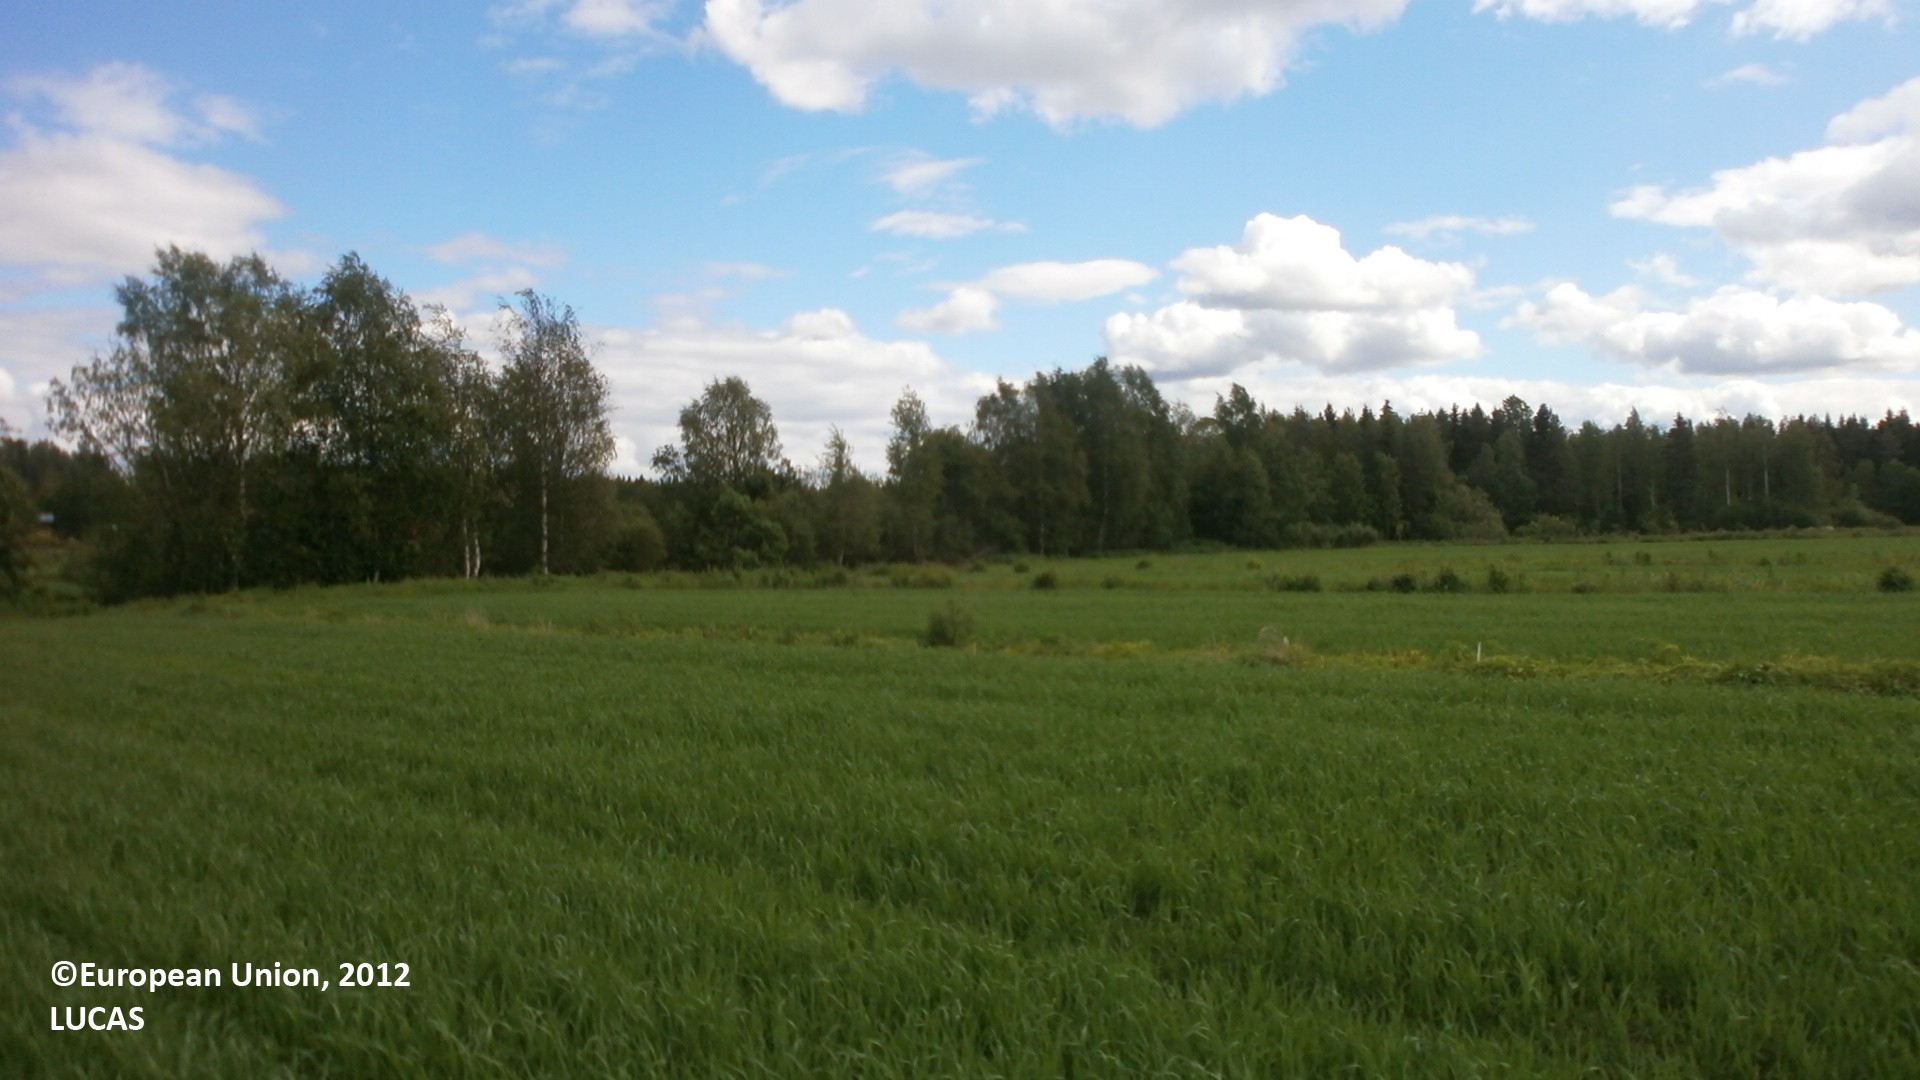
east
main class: Cropland
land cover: Oats
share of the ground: > 75 %
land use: Agriculture (excluding fallow land and kitchen gardens)
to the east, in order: Oats; Ditches and canals; Spontaneously vegetated surfaces; Broadleaved woodland; Inland running water; Shrubland without tree cover; Ditches and canals; Arable land (only in case pi); Ditches and canals; Arable land (only in case pi); Ditches and canals; Arable land (only in case pi); Ditches and canals; Arable land (only in case pi); Ditches and canals; Other mixed woodland
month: June
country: FI
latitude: 64.2770
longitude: 24.9278
